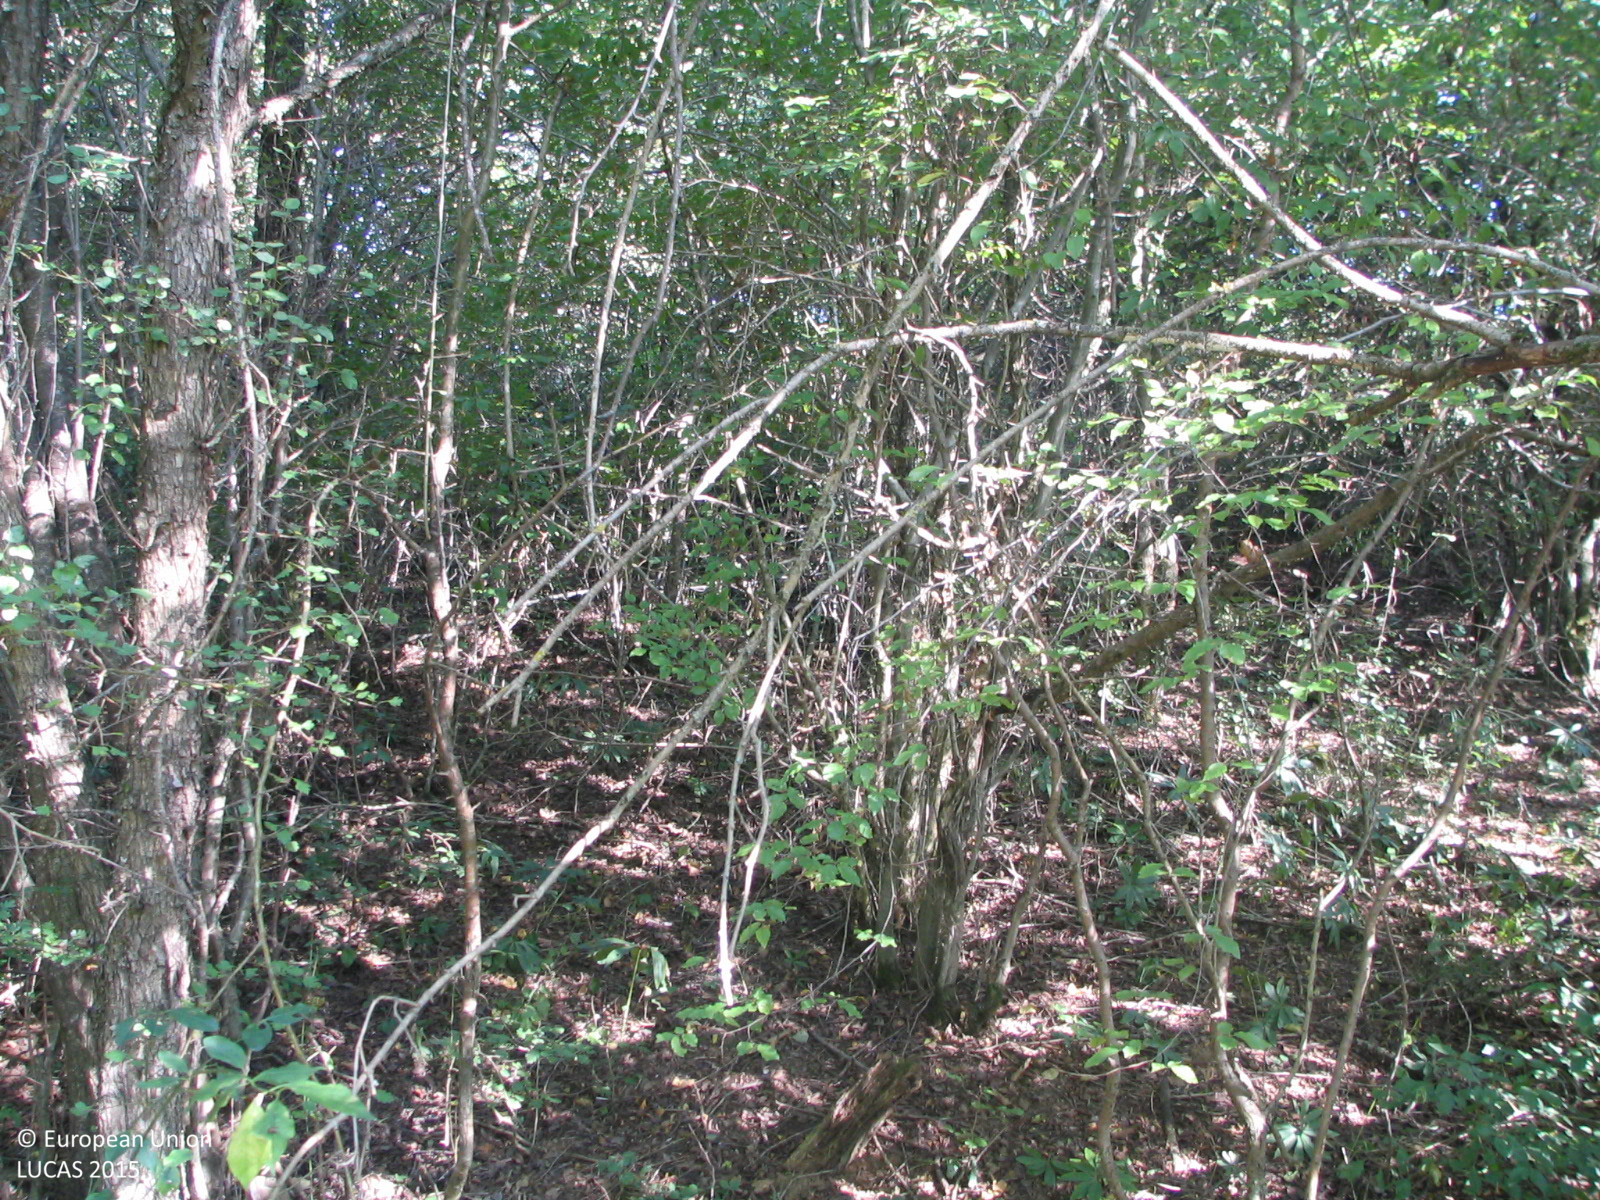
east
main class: Woodland
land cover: Broadleaved woodland
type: mesophytic deciduous forest
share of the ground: 50 - 75 %
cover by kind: broadleaved forest trees 70 %, shrubs 30 %
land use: Forestry
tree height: > 5 m
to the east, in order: Broadleaved woodland; Grassland with sparse tree/shrub cover; Fences; Grassland with sparse tree/shrub cover; Fences; Spontaneously vegetated surfaces
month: August
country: BG
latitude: 43.1170
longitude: 24.4234
